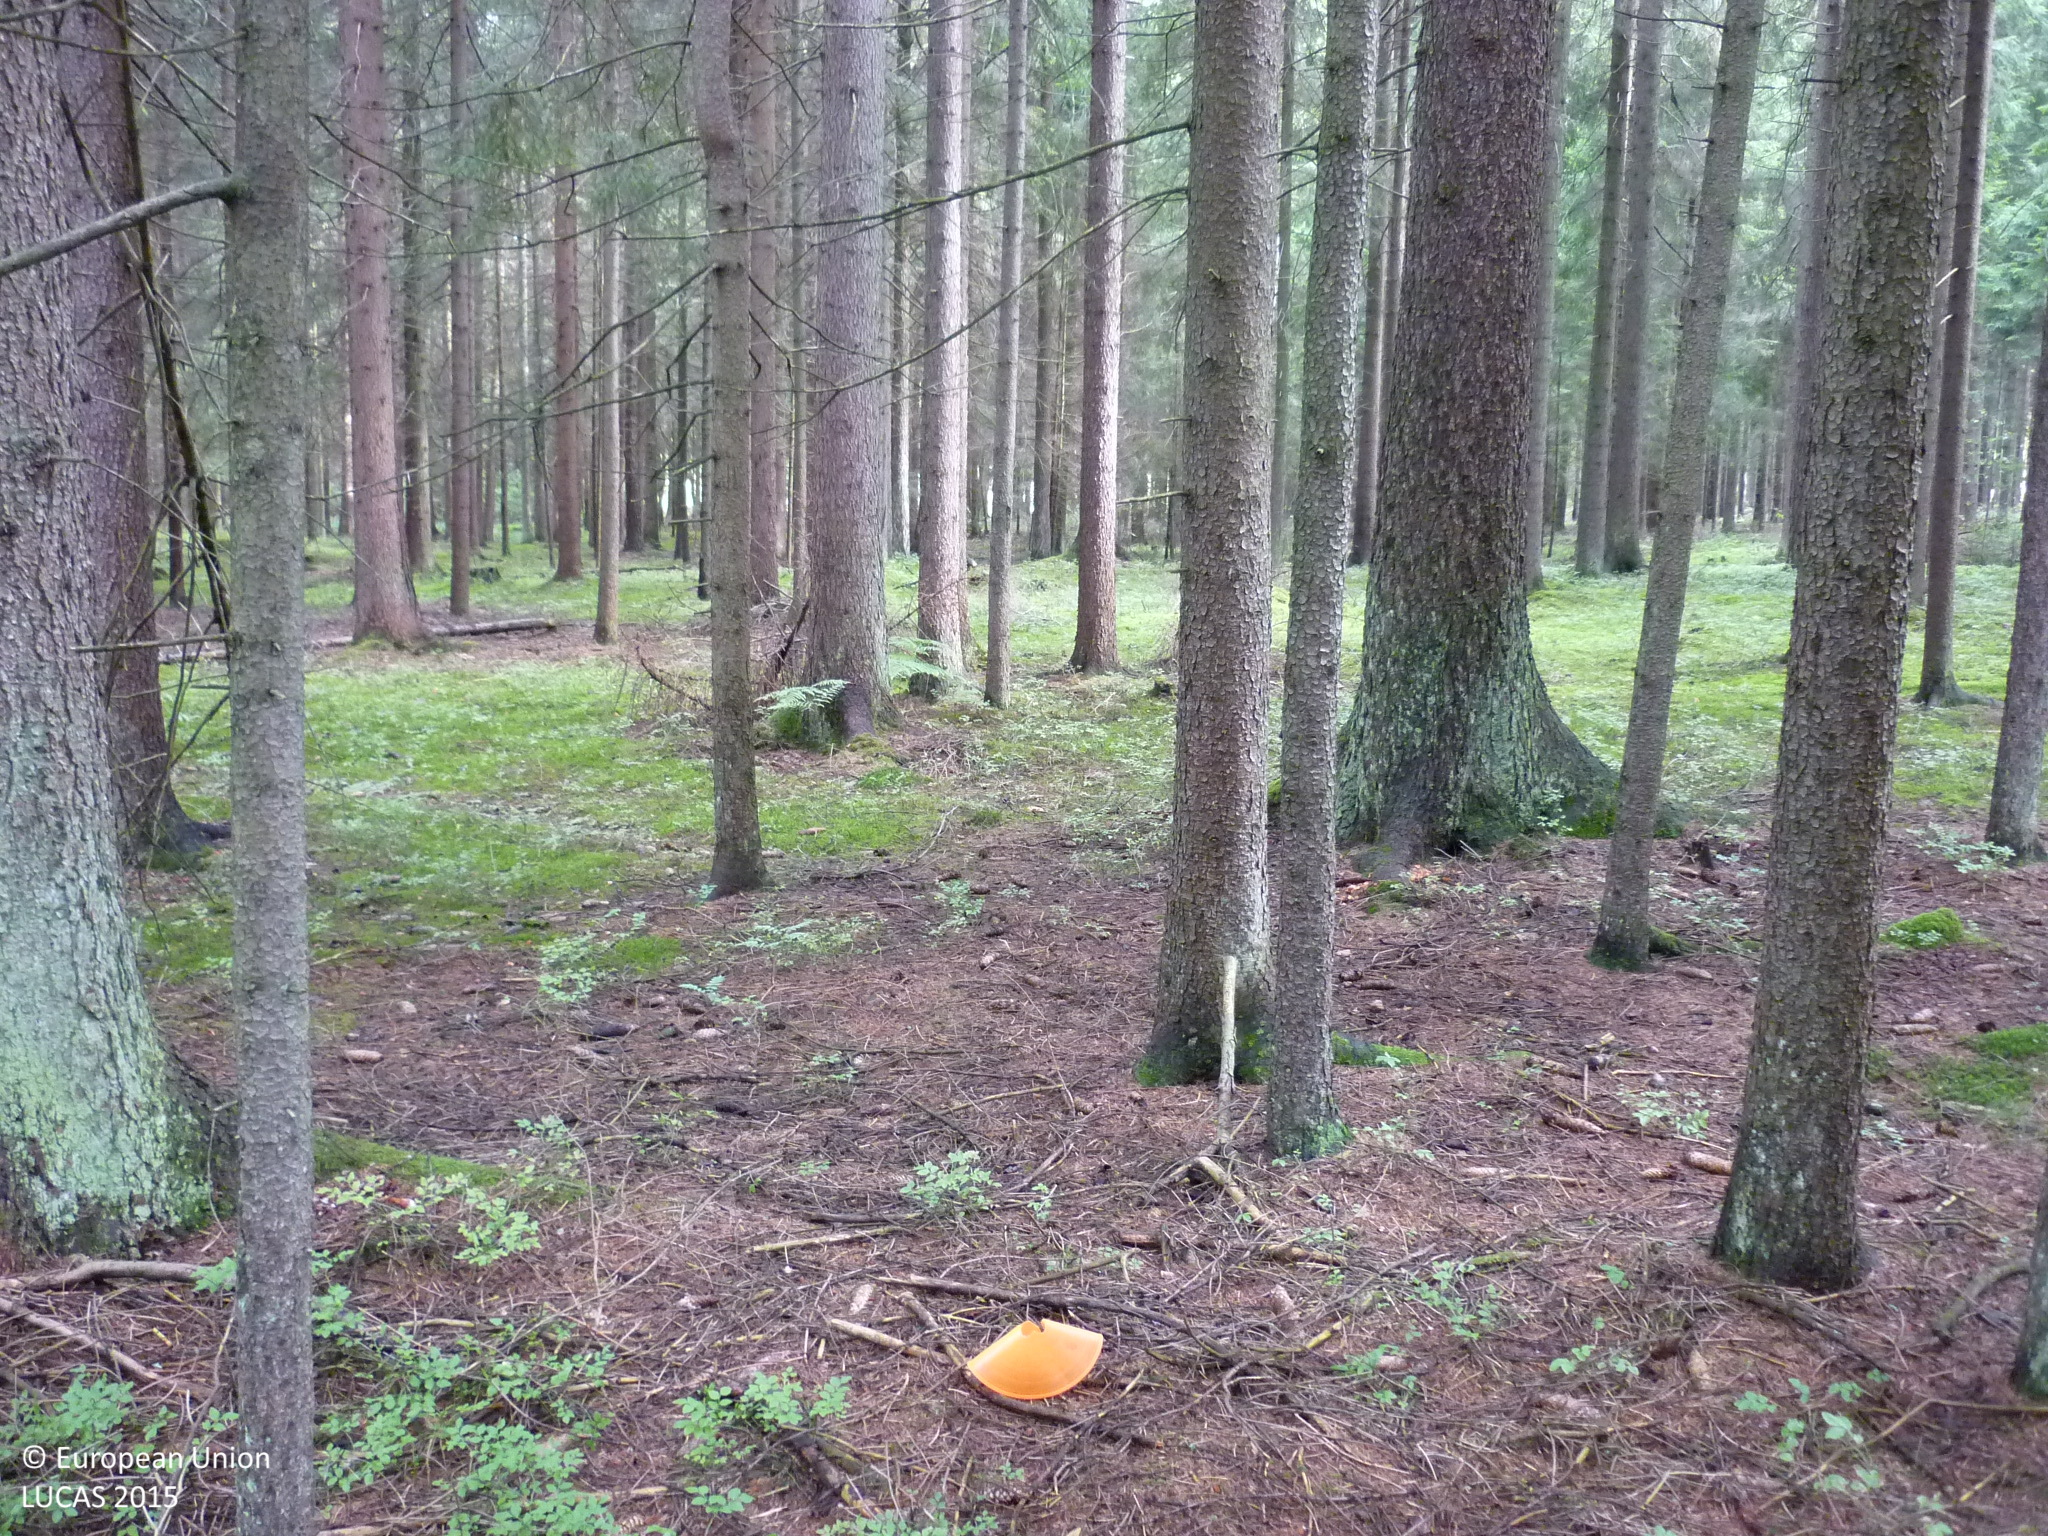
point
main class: Woodland
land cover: Spruce dominated coniferous woodland
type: hemiboreal forest and nemoral coniferous forest and mixed broadleaved-coniferous forest
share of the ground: > 75 %
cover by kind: coniferous forest trees 100 %
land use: Forestry
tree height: > 5 m
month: September
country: AT
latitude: 48.9159
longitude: 15.1195
